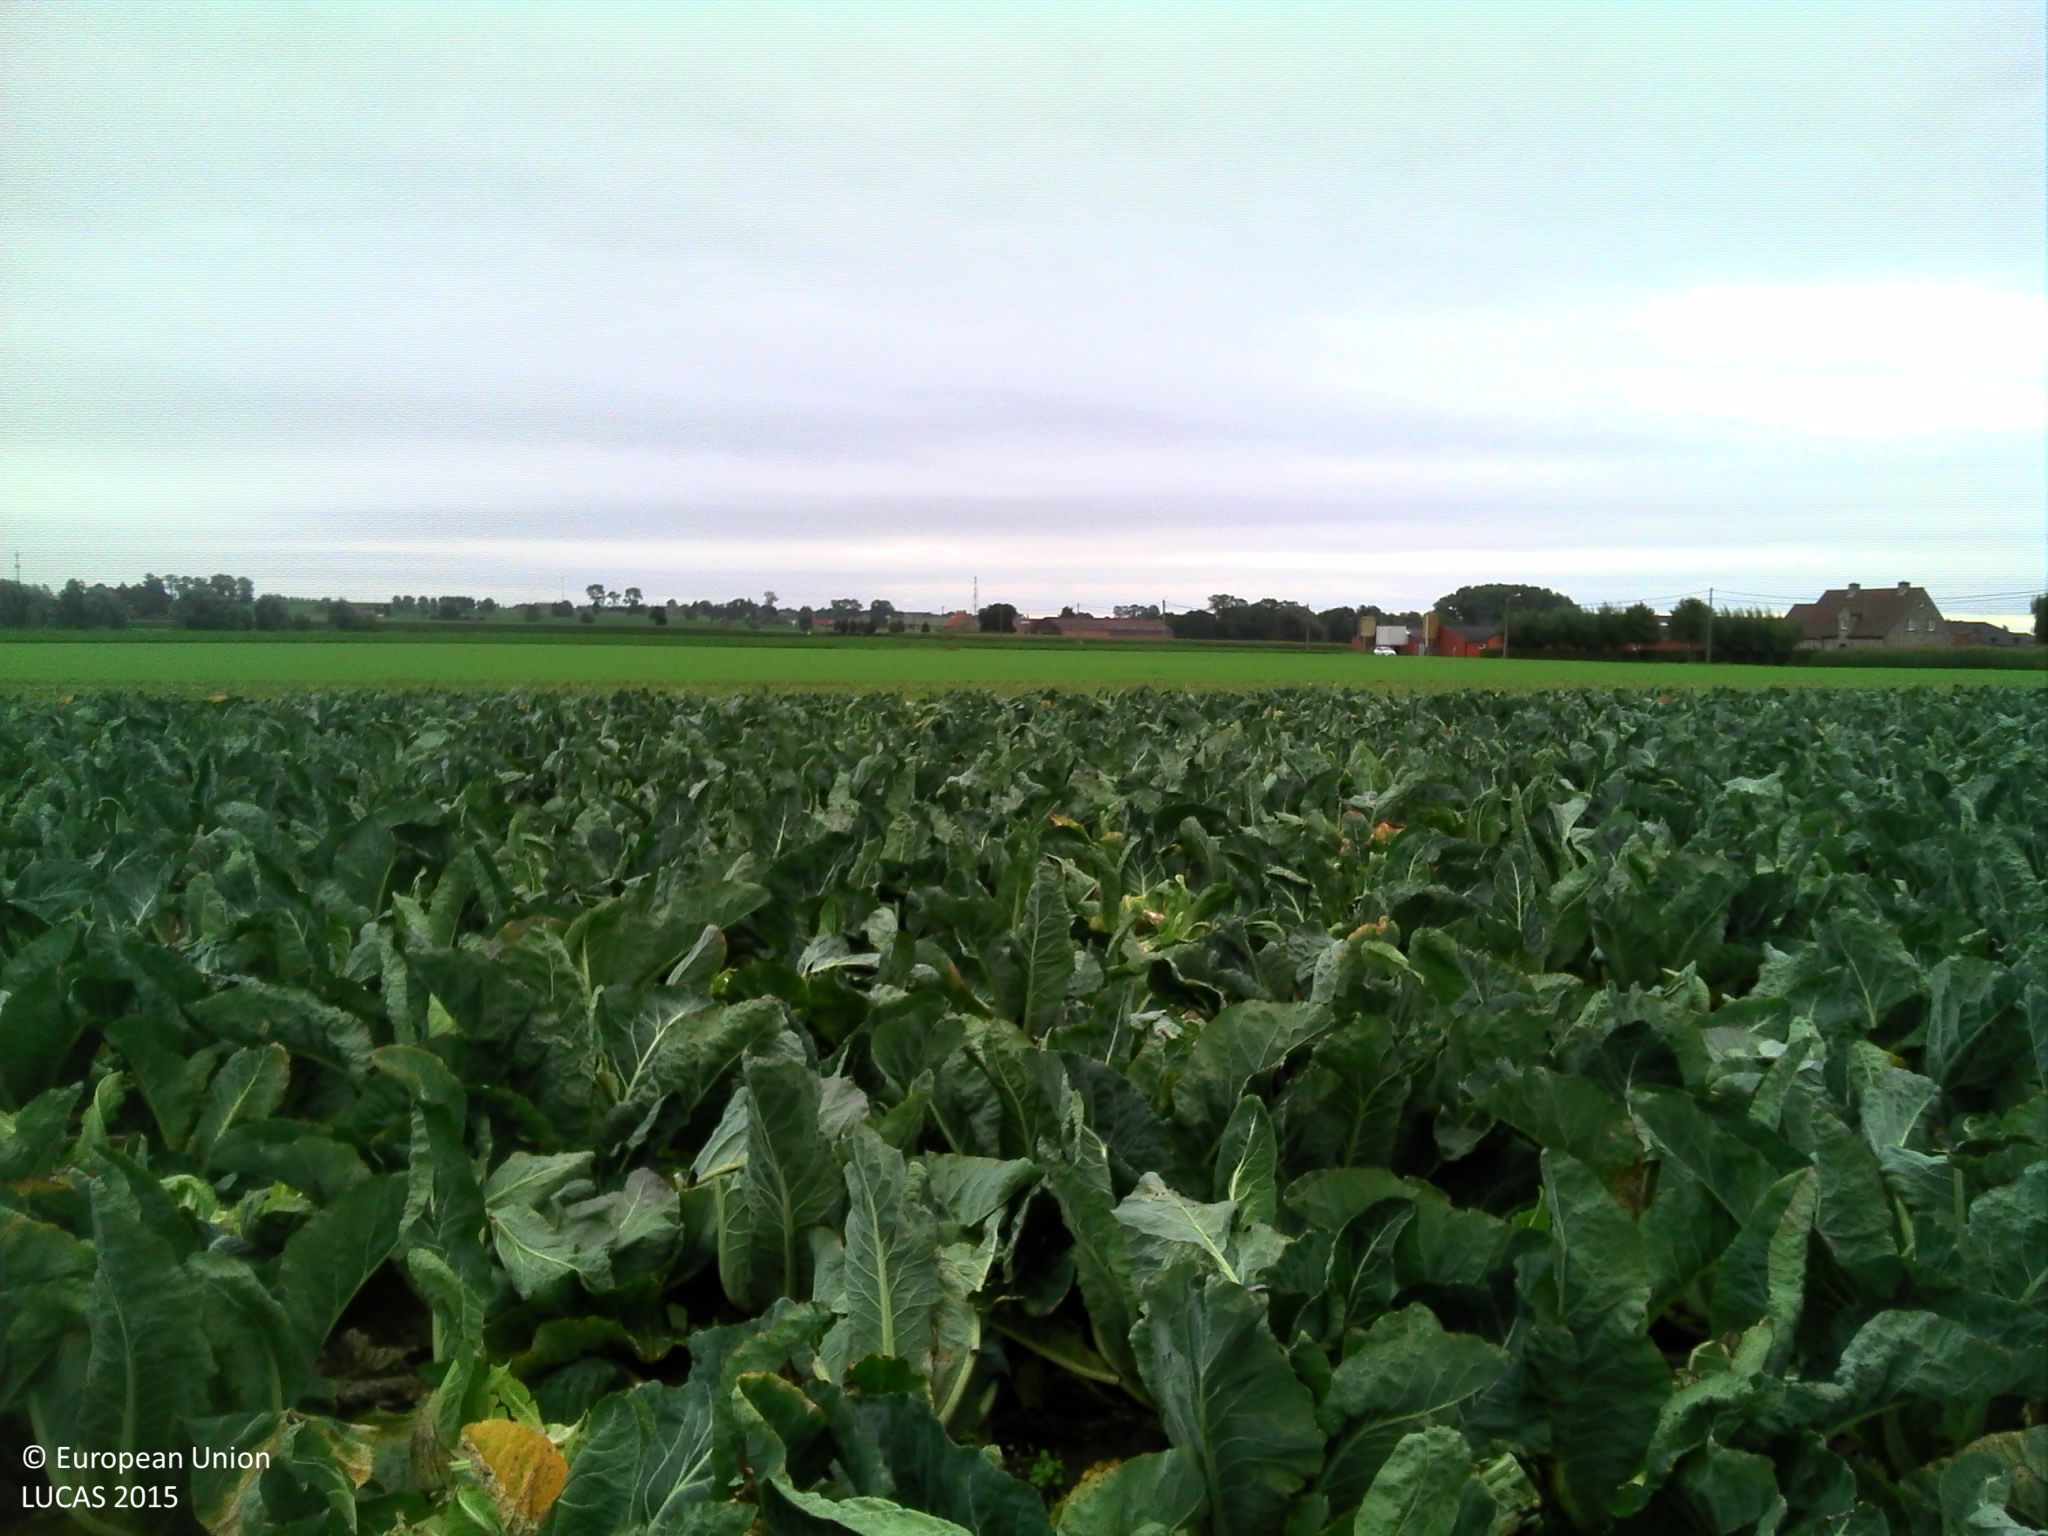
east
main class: Cropland
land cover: Other fresh vegetables
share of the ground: > 75 %
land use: Agriculture (excluding fallow land and kitchen gardens)
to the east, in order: Other fresh vegetables; Common wheat; Temporary grasslands; Other fresh vegetables
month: September
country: BE
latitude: 51.0690
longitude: 2.9828
